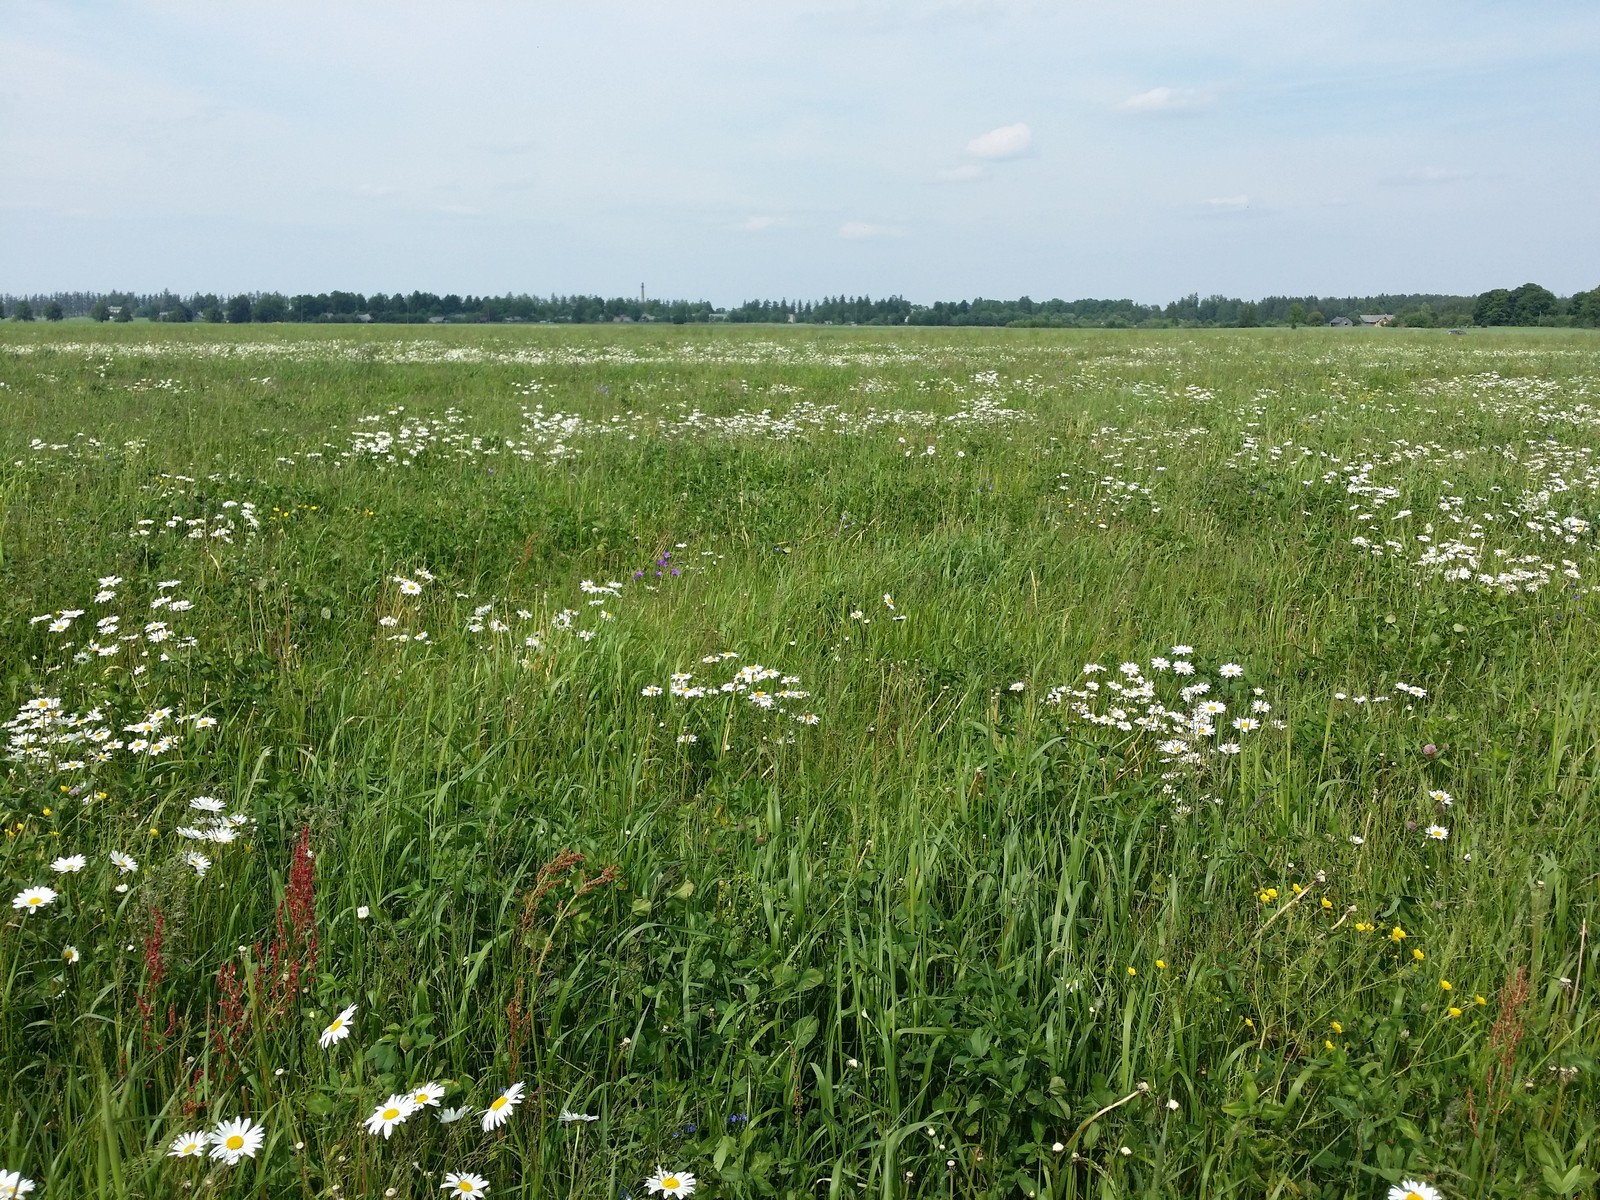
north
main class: Grassland
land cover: Grassland without tree/shrub cover
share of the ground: > 75 %
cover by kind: herbaceous plants 100 %
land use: Agriculture (excluding fallow land and kitchen gardens)
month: June
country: LV
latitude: 57.4354
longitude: 26.5868
